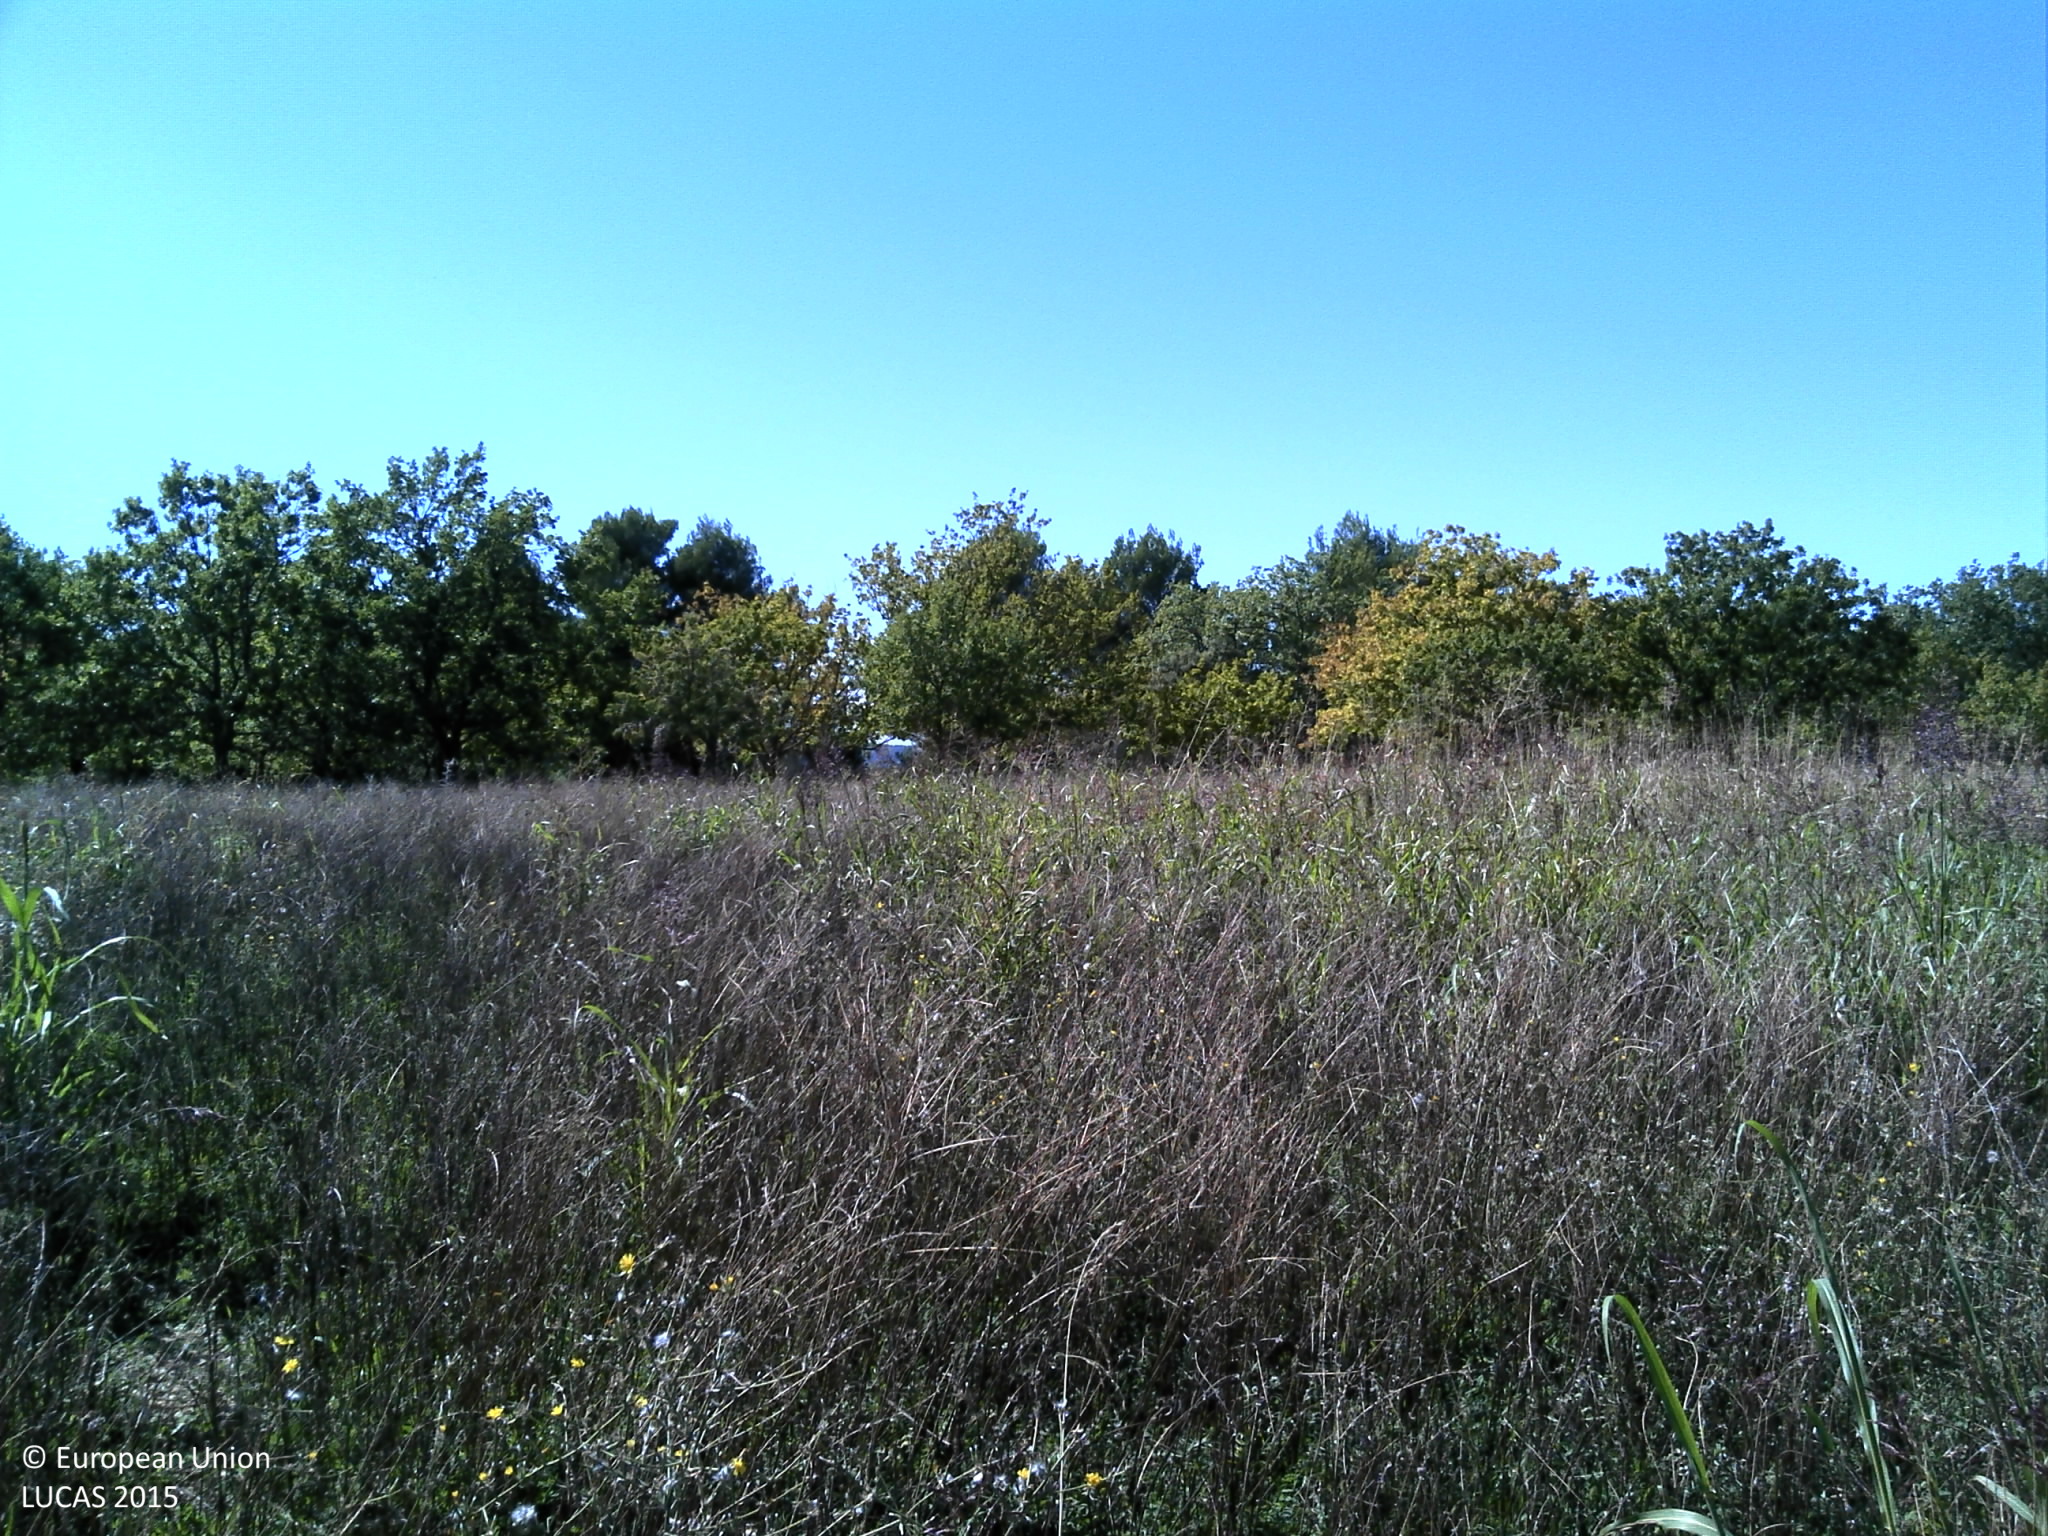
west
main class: Cropland
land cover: Other leguminous and mixtures for fodder
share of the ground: > 75 %
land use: Agriculture (excluding fallow land and kitchen gardens)
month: September
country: FR
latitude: 43.7641
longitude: 5.4750
